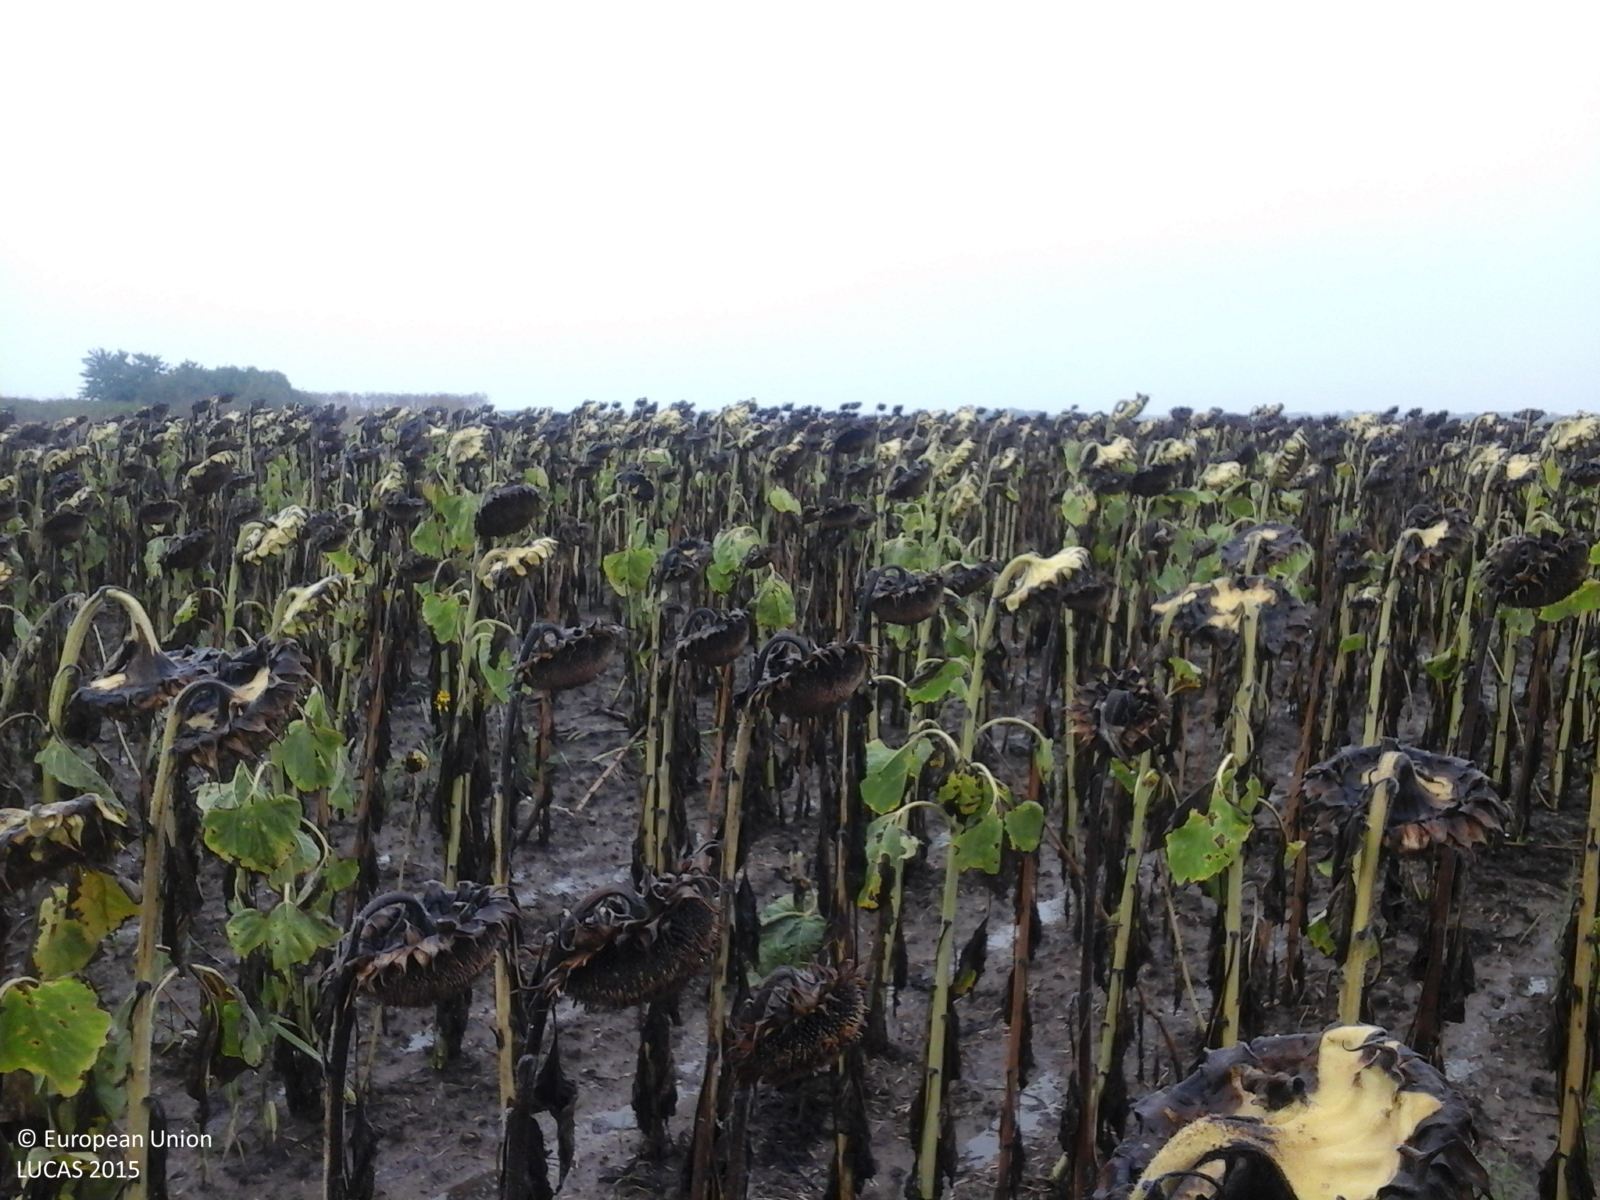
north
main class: Cropland
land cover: Sunflower
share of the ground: > 75 %
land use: Agriculture (excluding fallow land and kitchen gardens)
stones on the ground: 10 - 25 %
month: August
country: RO
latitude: 45.6620
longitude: 21.1048
